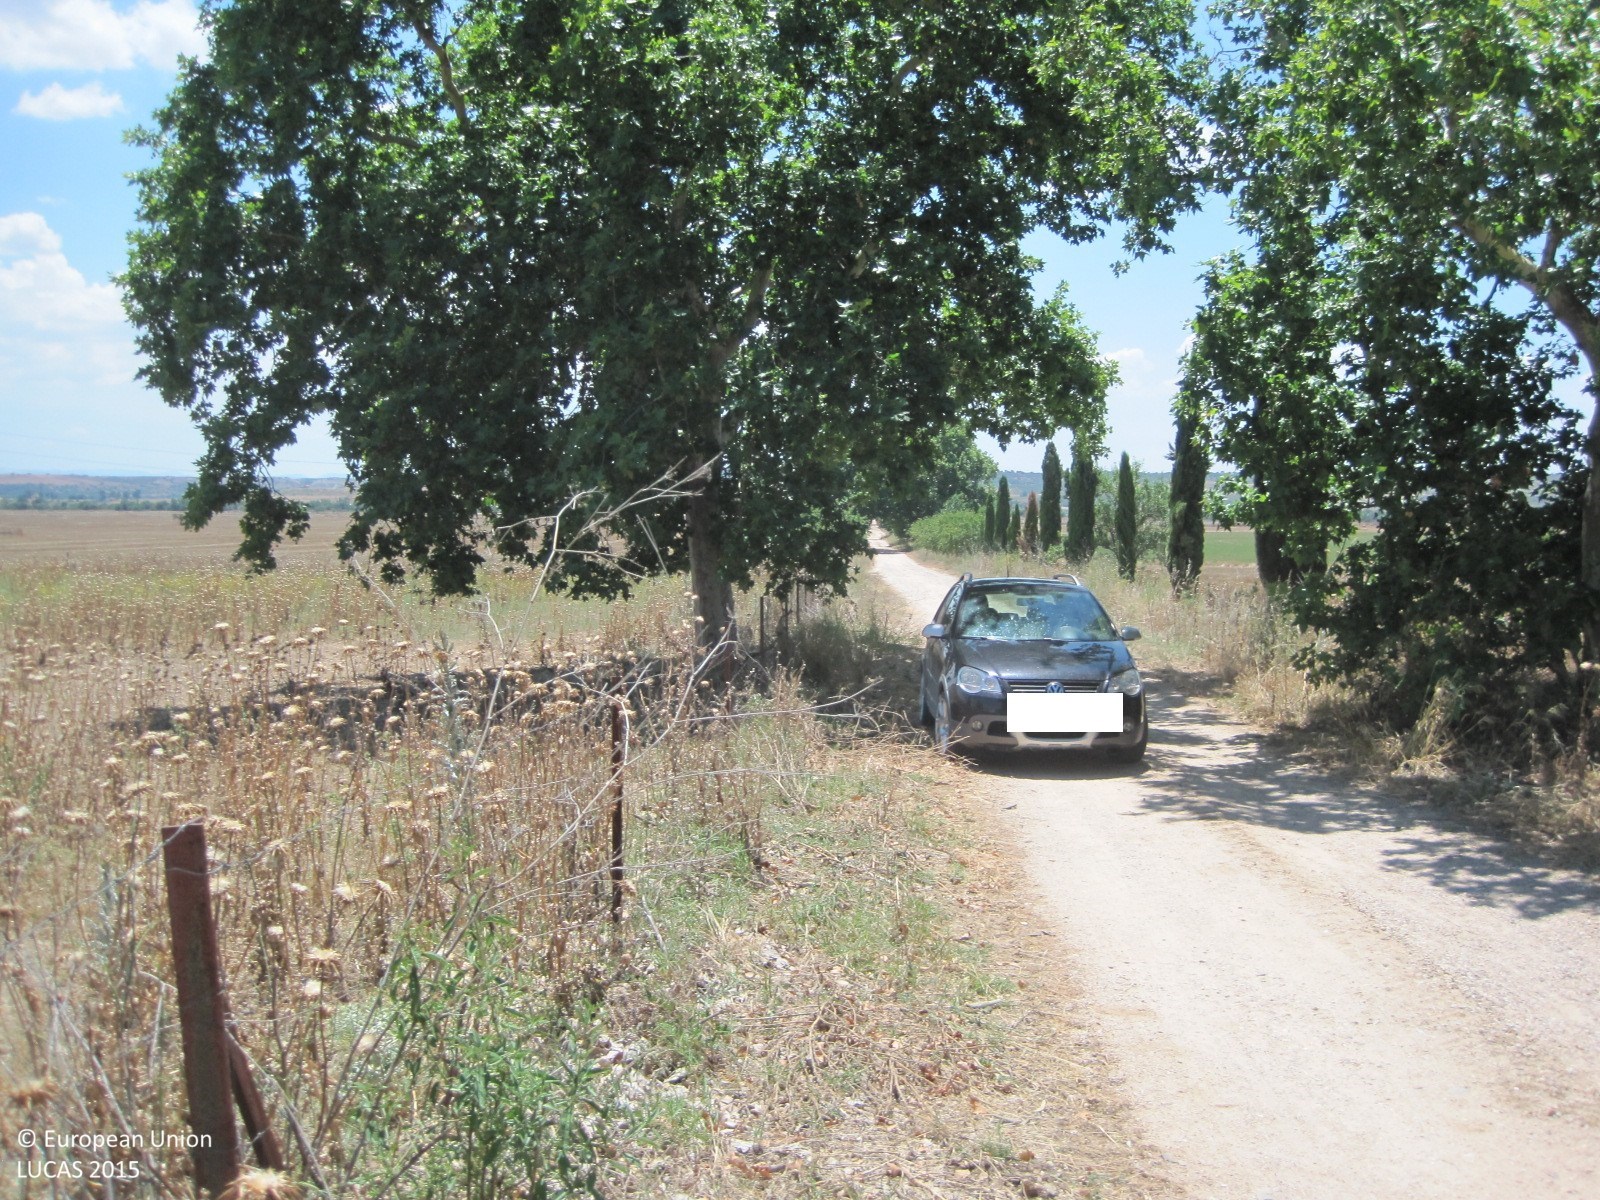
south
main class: Grassland
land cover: Grassland with sparse tree/shrub cover
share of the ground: > 75 %
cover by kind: herbaceous plants 70 %, unconsolidated bare surface 25 %, coniferous forest trees 5 %
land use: Agriculture (excluding fallow land and kitchen gardens)
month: June
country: ES
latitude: 39.9800
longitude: -4.6949
